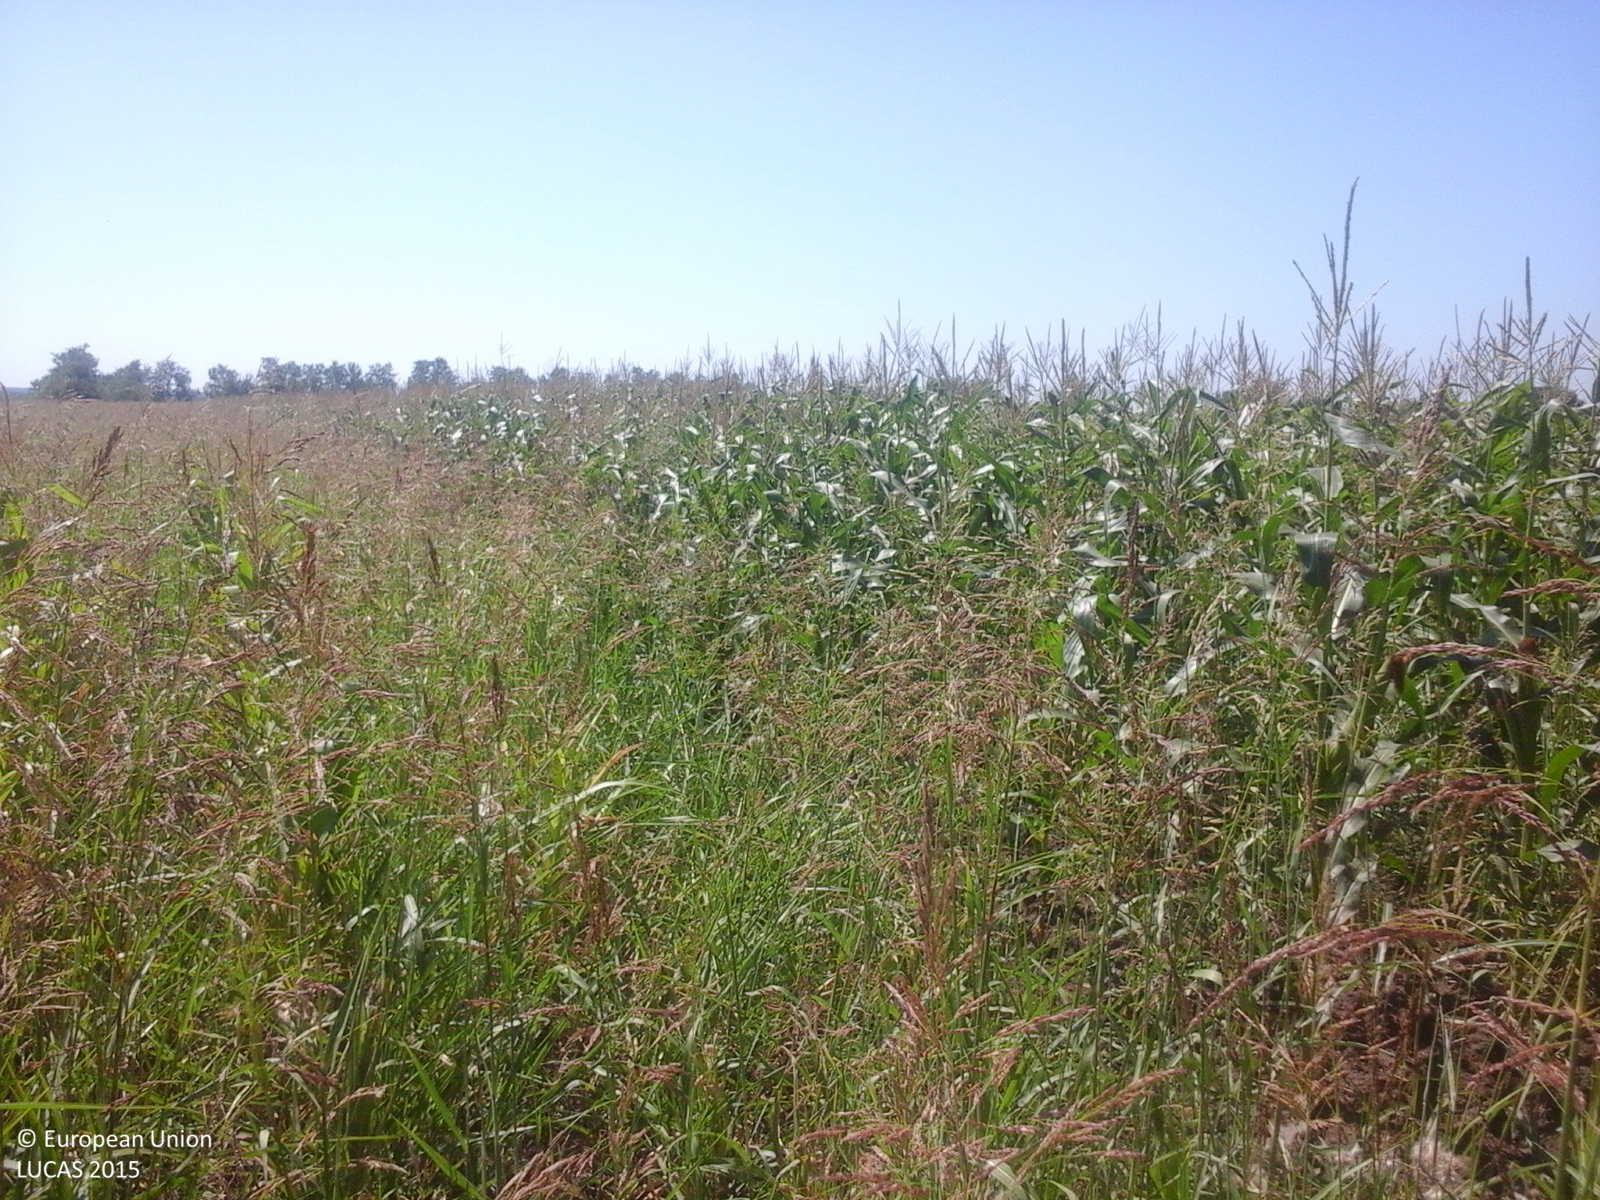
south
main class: Grassland
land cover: Spontaneously vegetated surfaces
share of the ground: 50 - 75 %
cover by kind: herbaceous plants 100 %
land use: Fallow land
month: July
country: RO
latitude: 44.2331
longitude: 26.6044
